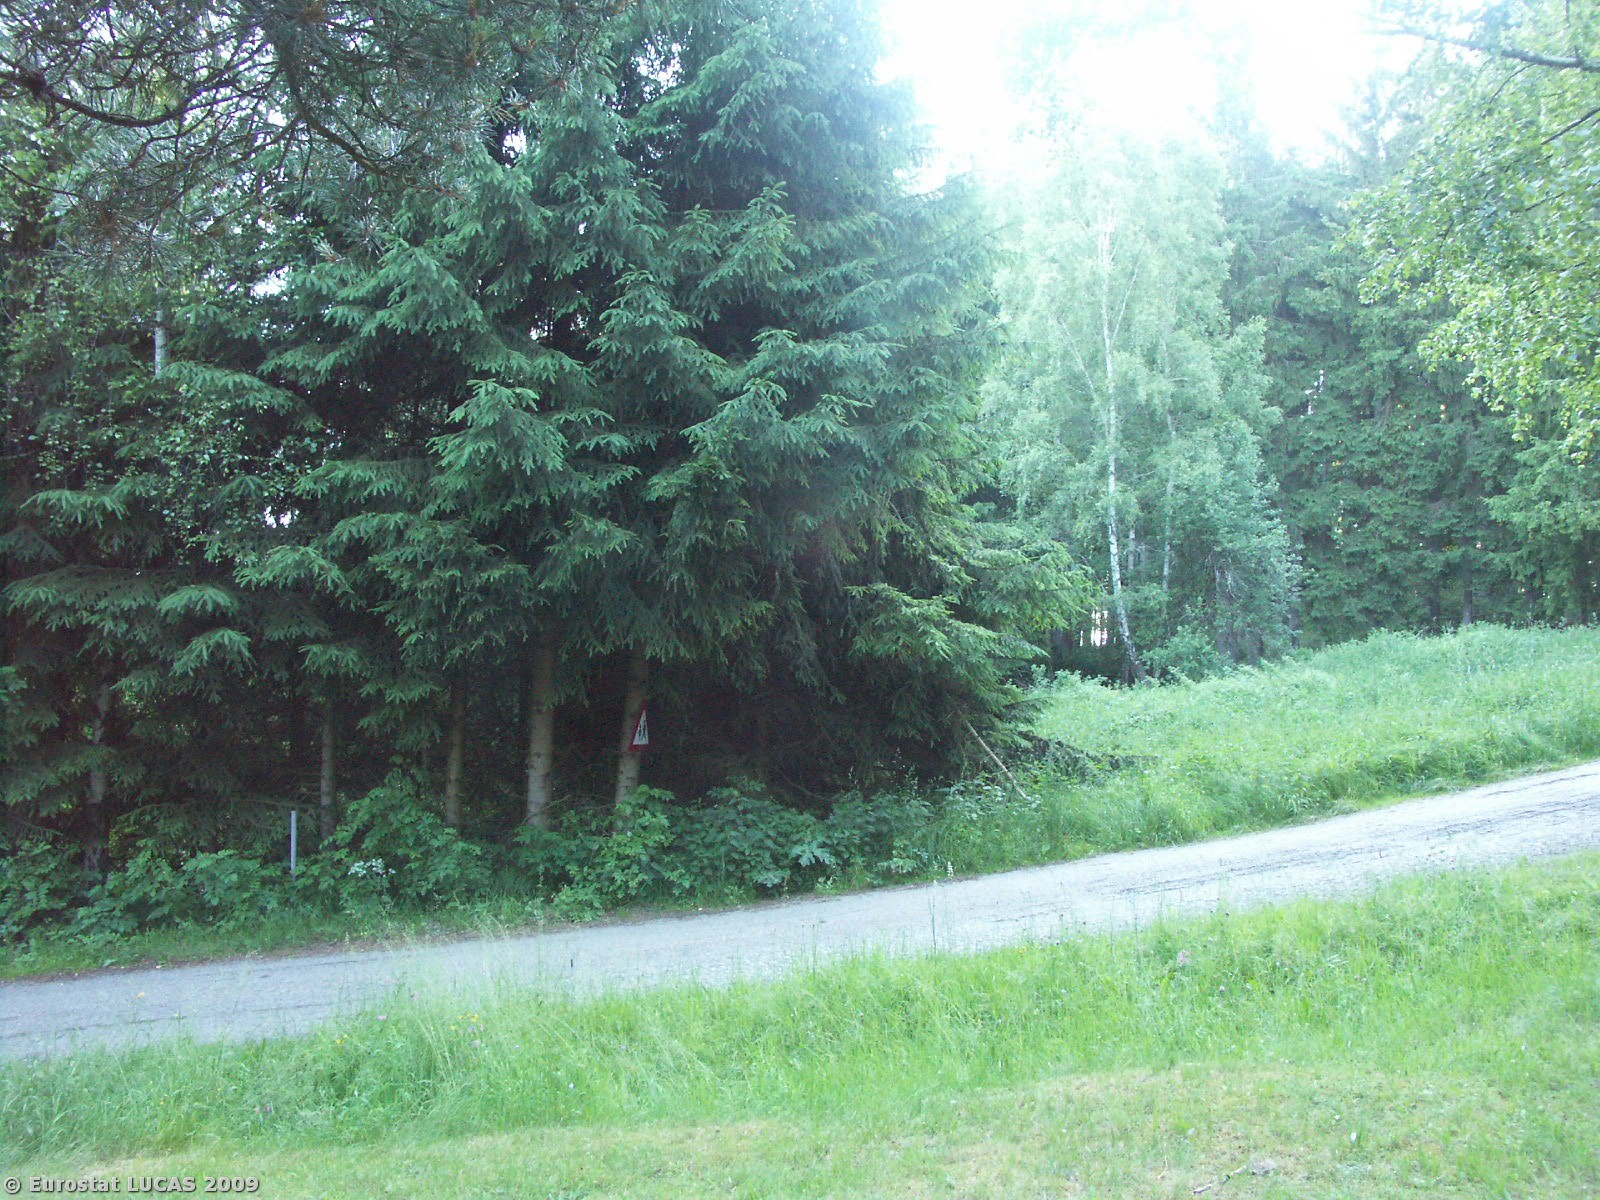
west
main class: Woodland
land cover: Coniferous woodland
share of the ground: 50 - 75 %
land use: Holiday camps
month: June
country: CZ
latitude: 48.6682
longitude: 14.1418
